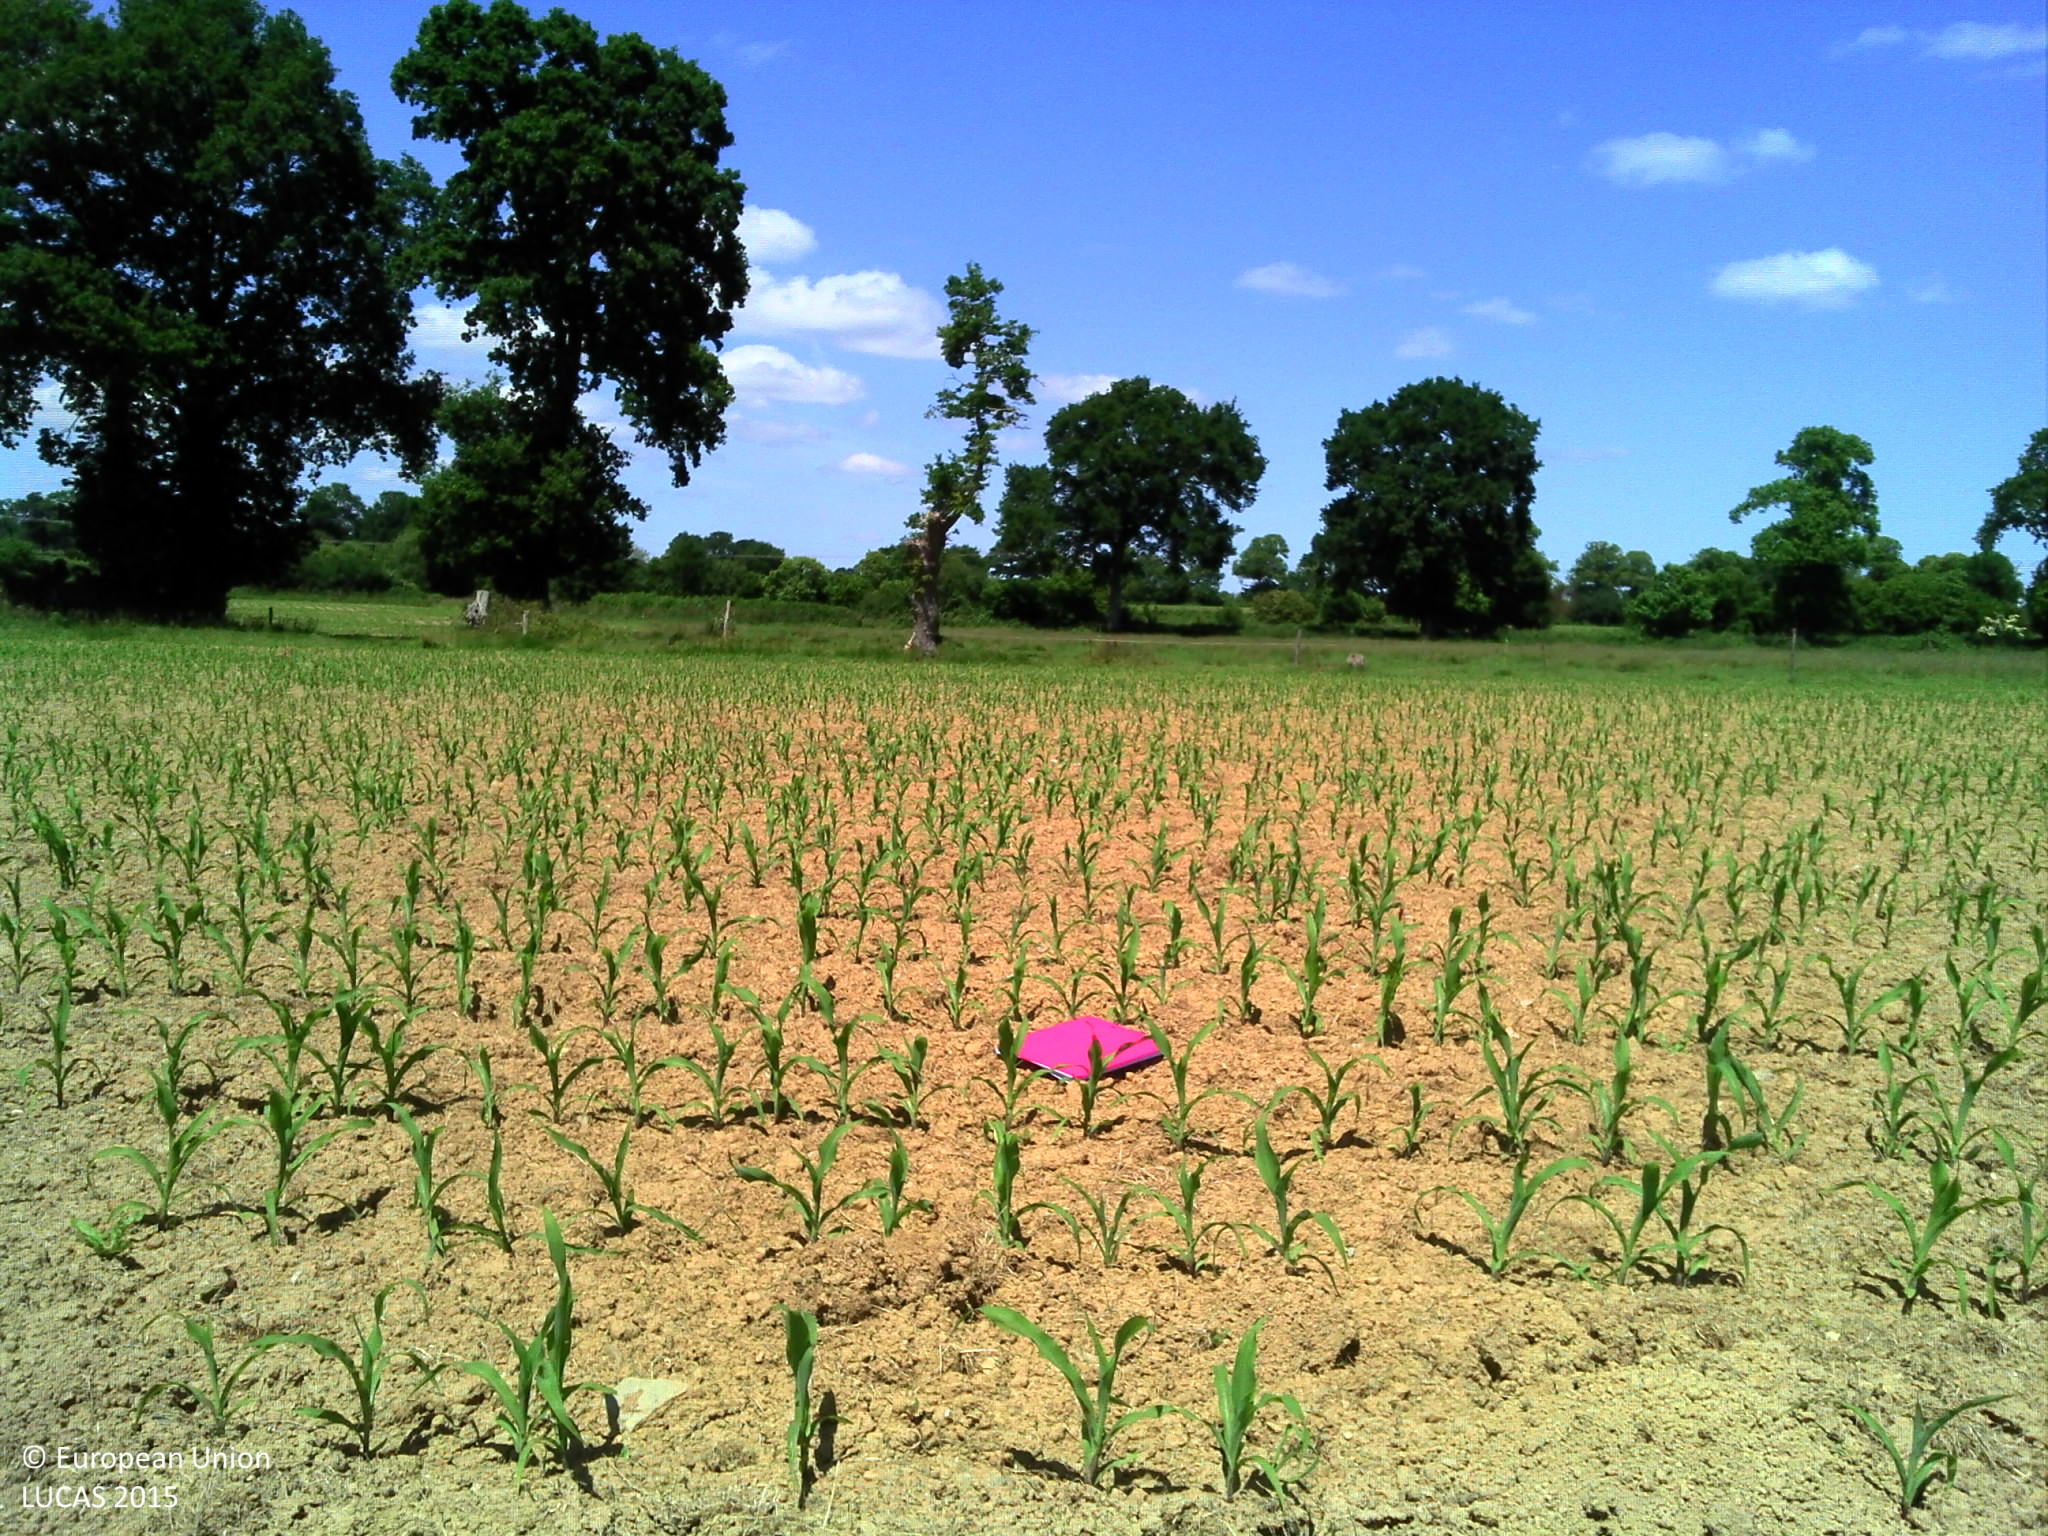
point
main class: Cropland
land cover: Maize
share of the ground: > 75 %
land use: Agriculture (excluding fallow land and kitchen gardens)
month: June
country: FR
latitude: 48.1305
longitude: -1.4798
